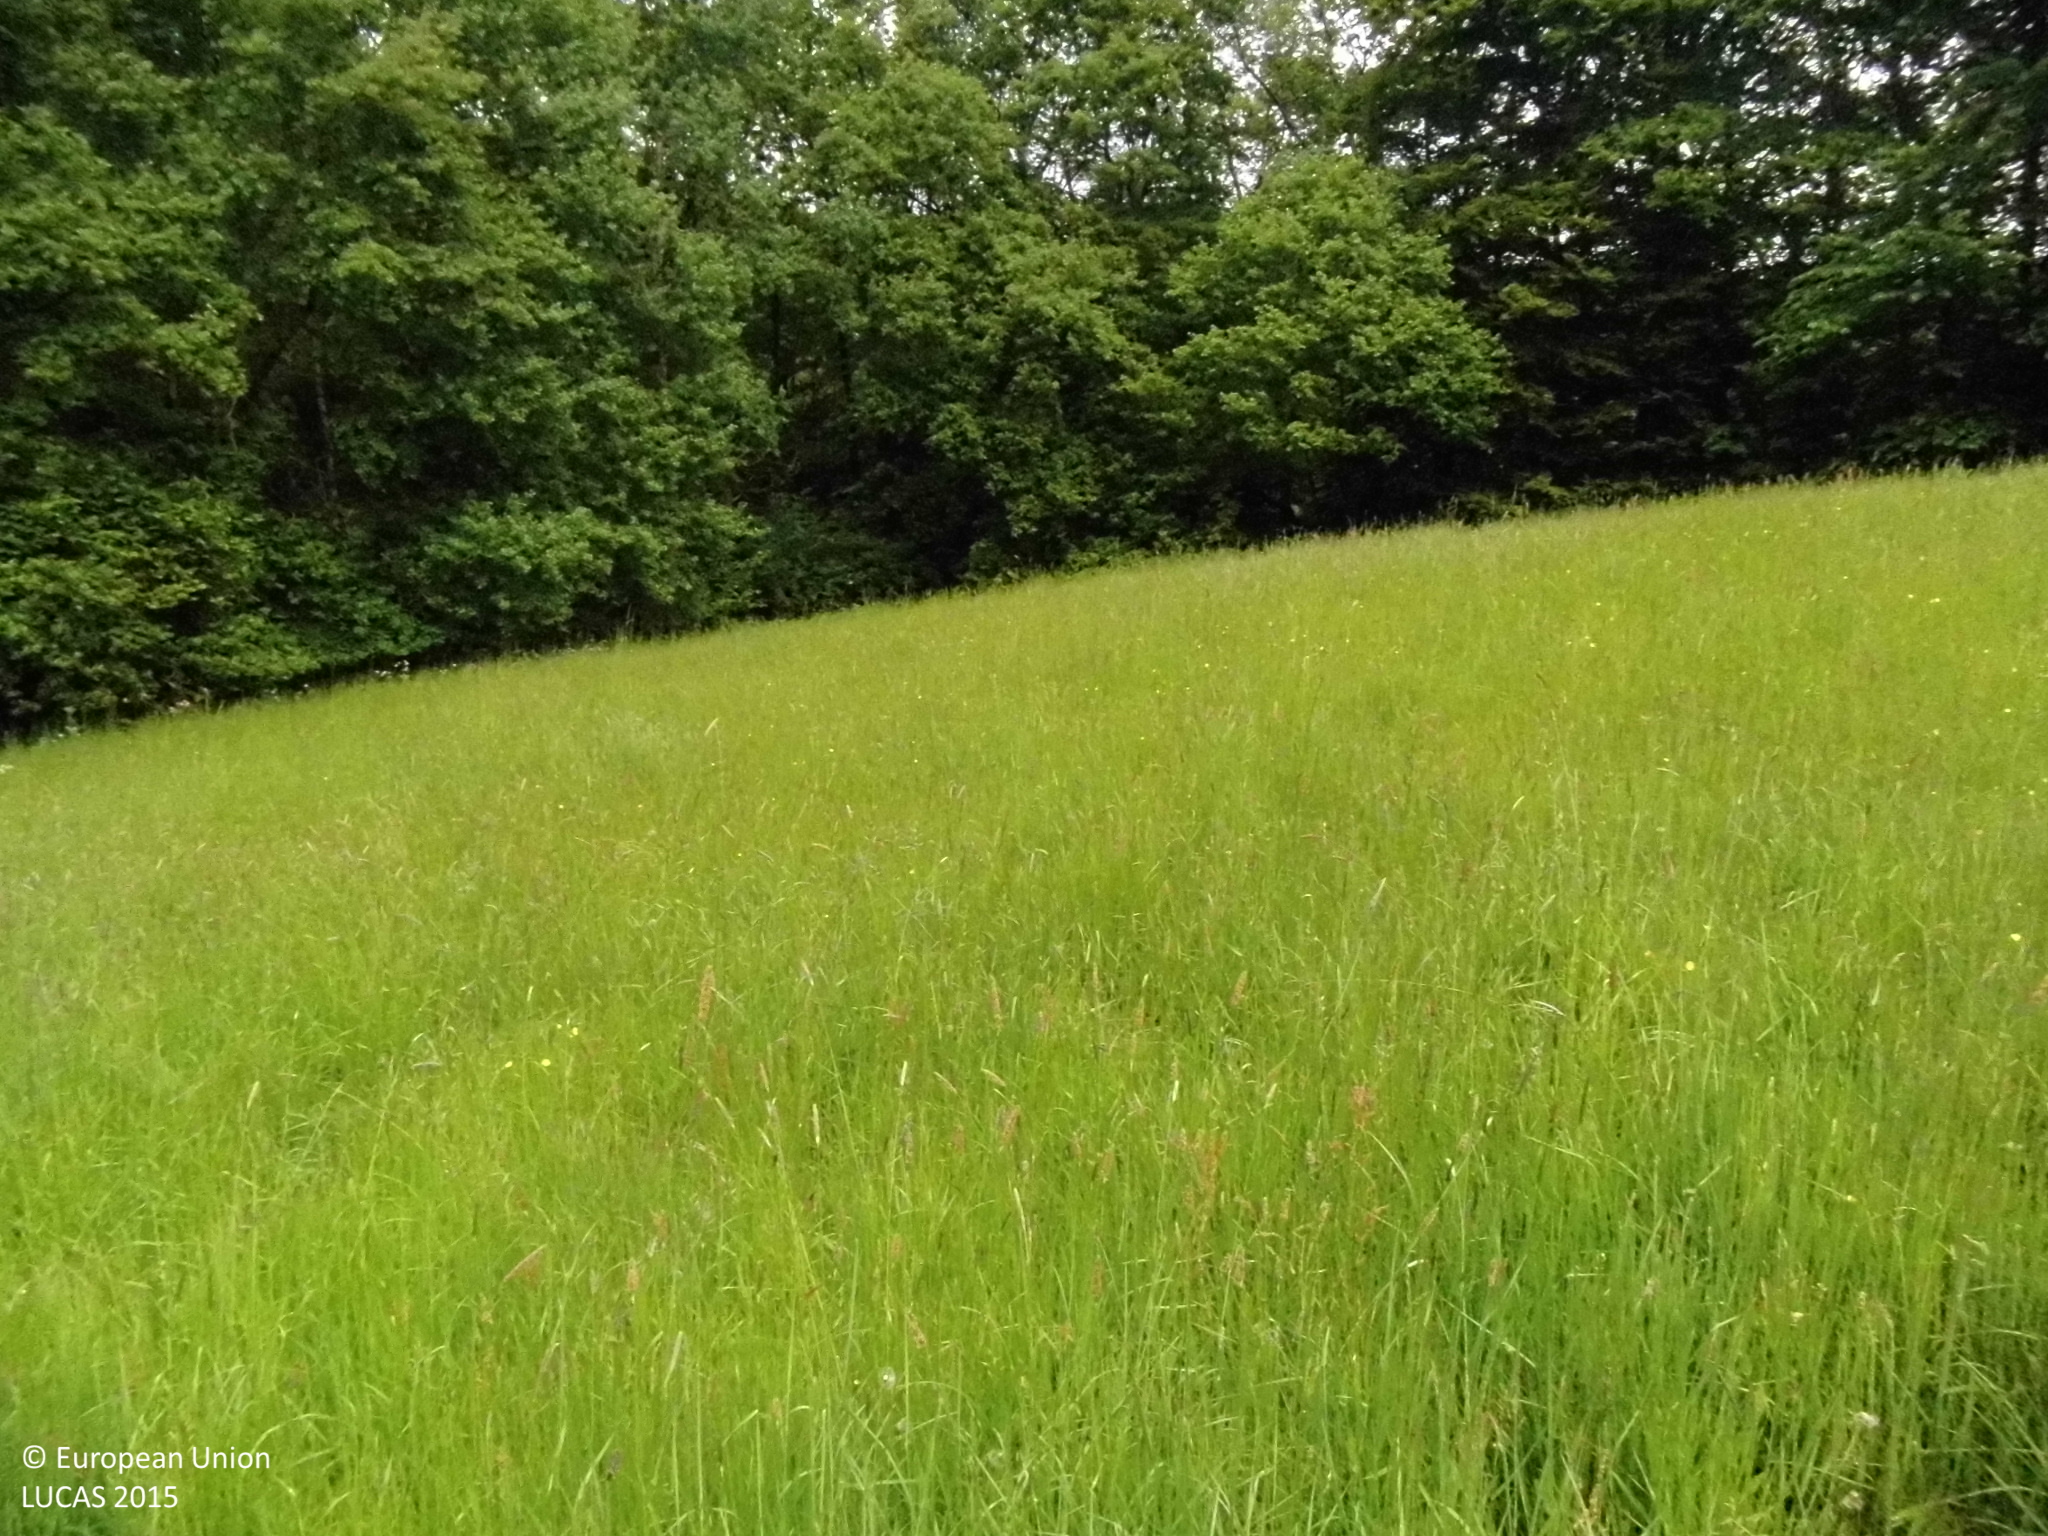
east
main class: Grassland
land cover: Grassland without tree/shrub cover
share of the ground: > 75 %
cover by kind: herbaceous plants 100 %
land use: Agriculture (excluding fallow land and kitchen gardens)
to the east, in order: Grassland without tree/shrub cover; Shrubland without tree cover; Broadleaved woodland; Fences; Broadleaved woodland; Ditches and canals; Broadleaved woodland; Shrubland without tree cover; Broadleaved woodland; Grassland without tree/shrub cover; Groves; Ditches and canals; Grass margins; Paved roads, cycling and walking lanes; Grass margins; Ditches and canals; Shruby margins; Broadleaved woodland; Grassland without tree/shrub cover; Broadleaved woodland
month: May
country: DE
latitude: 50.7131
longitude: 7.4368
